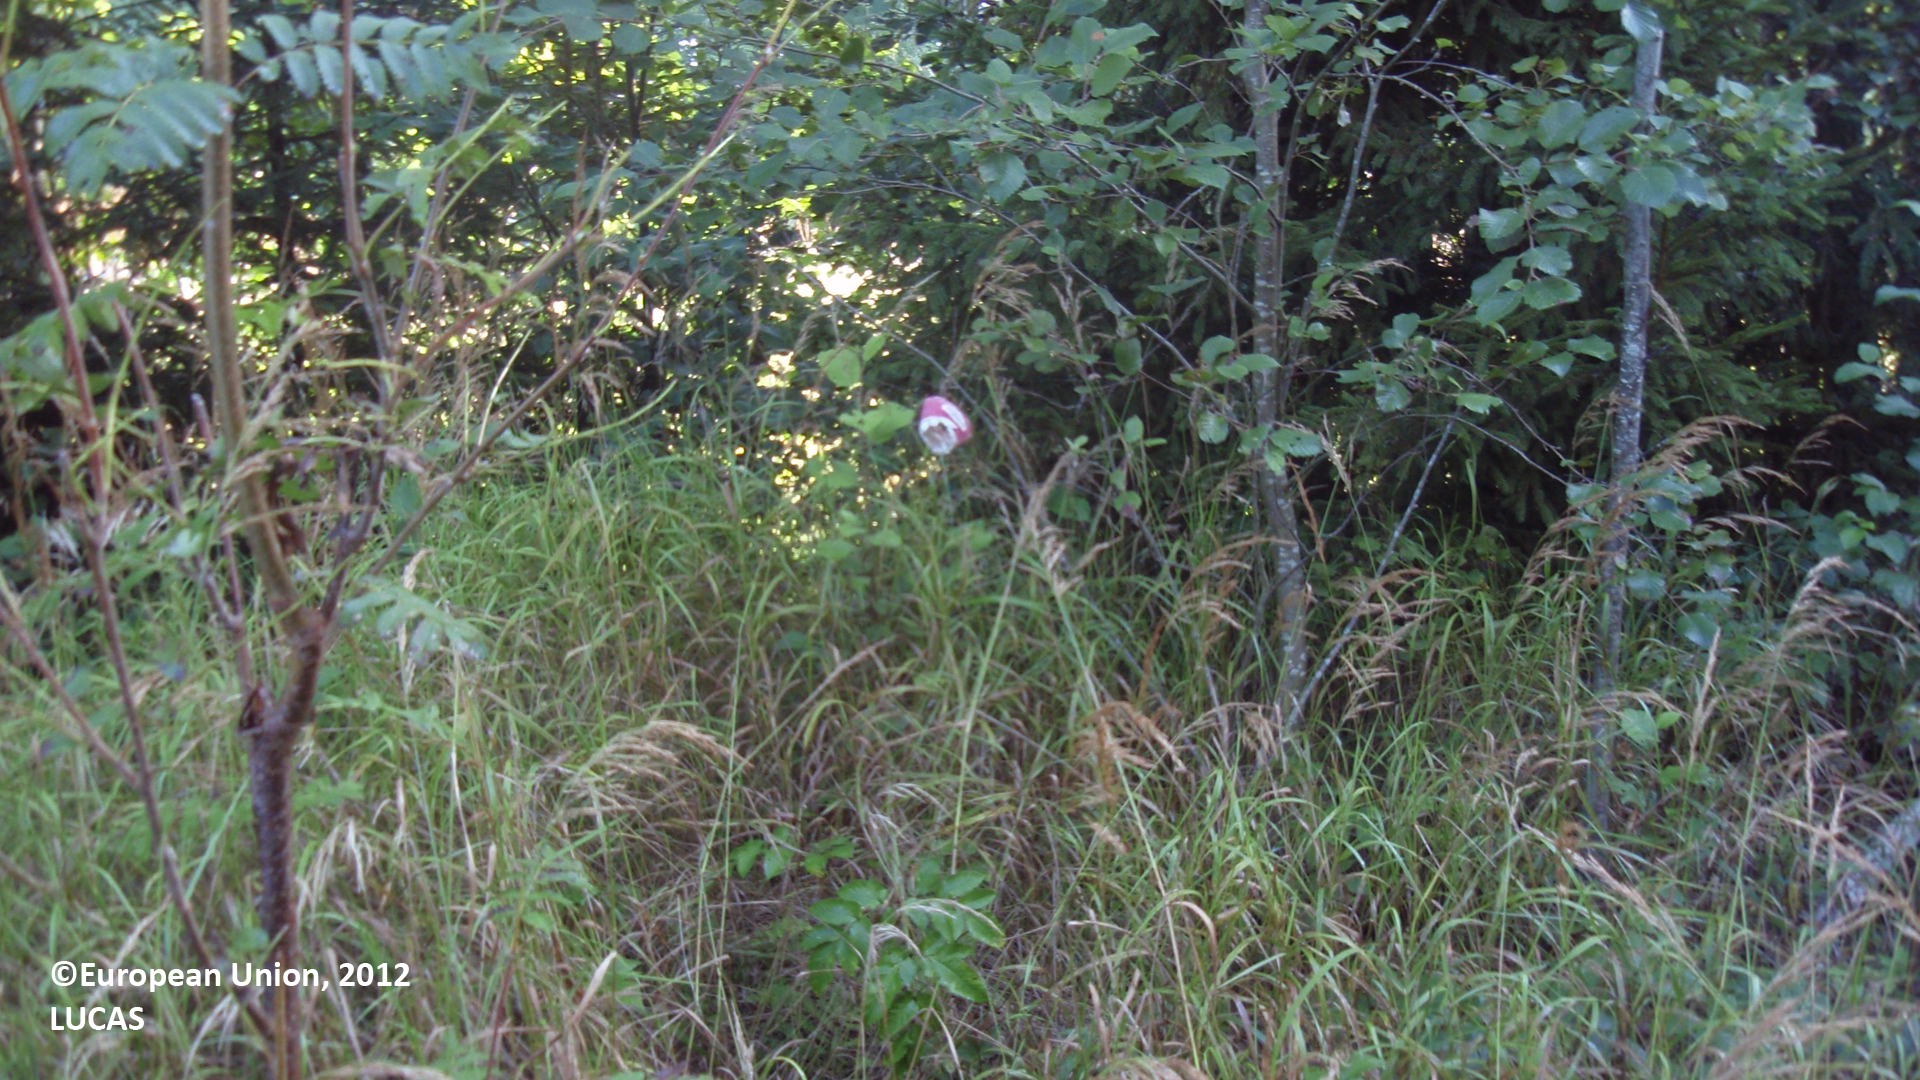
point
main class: Woodland
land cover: Broadleaved woodland
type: boreal forest
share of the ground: 50 - 75 %
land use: Forestry
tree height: > 5 m
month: August
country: FI
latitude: 60.6205
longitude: 27.2636
